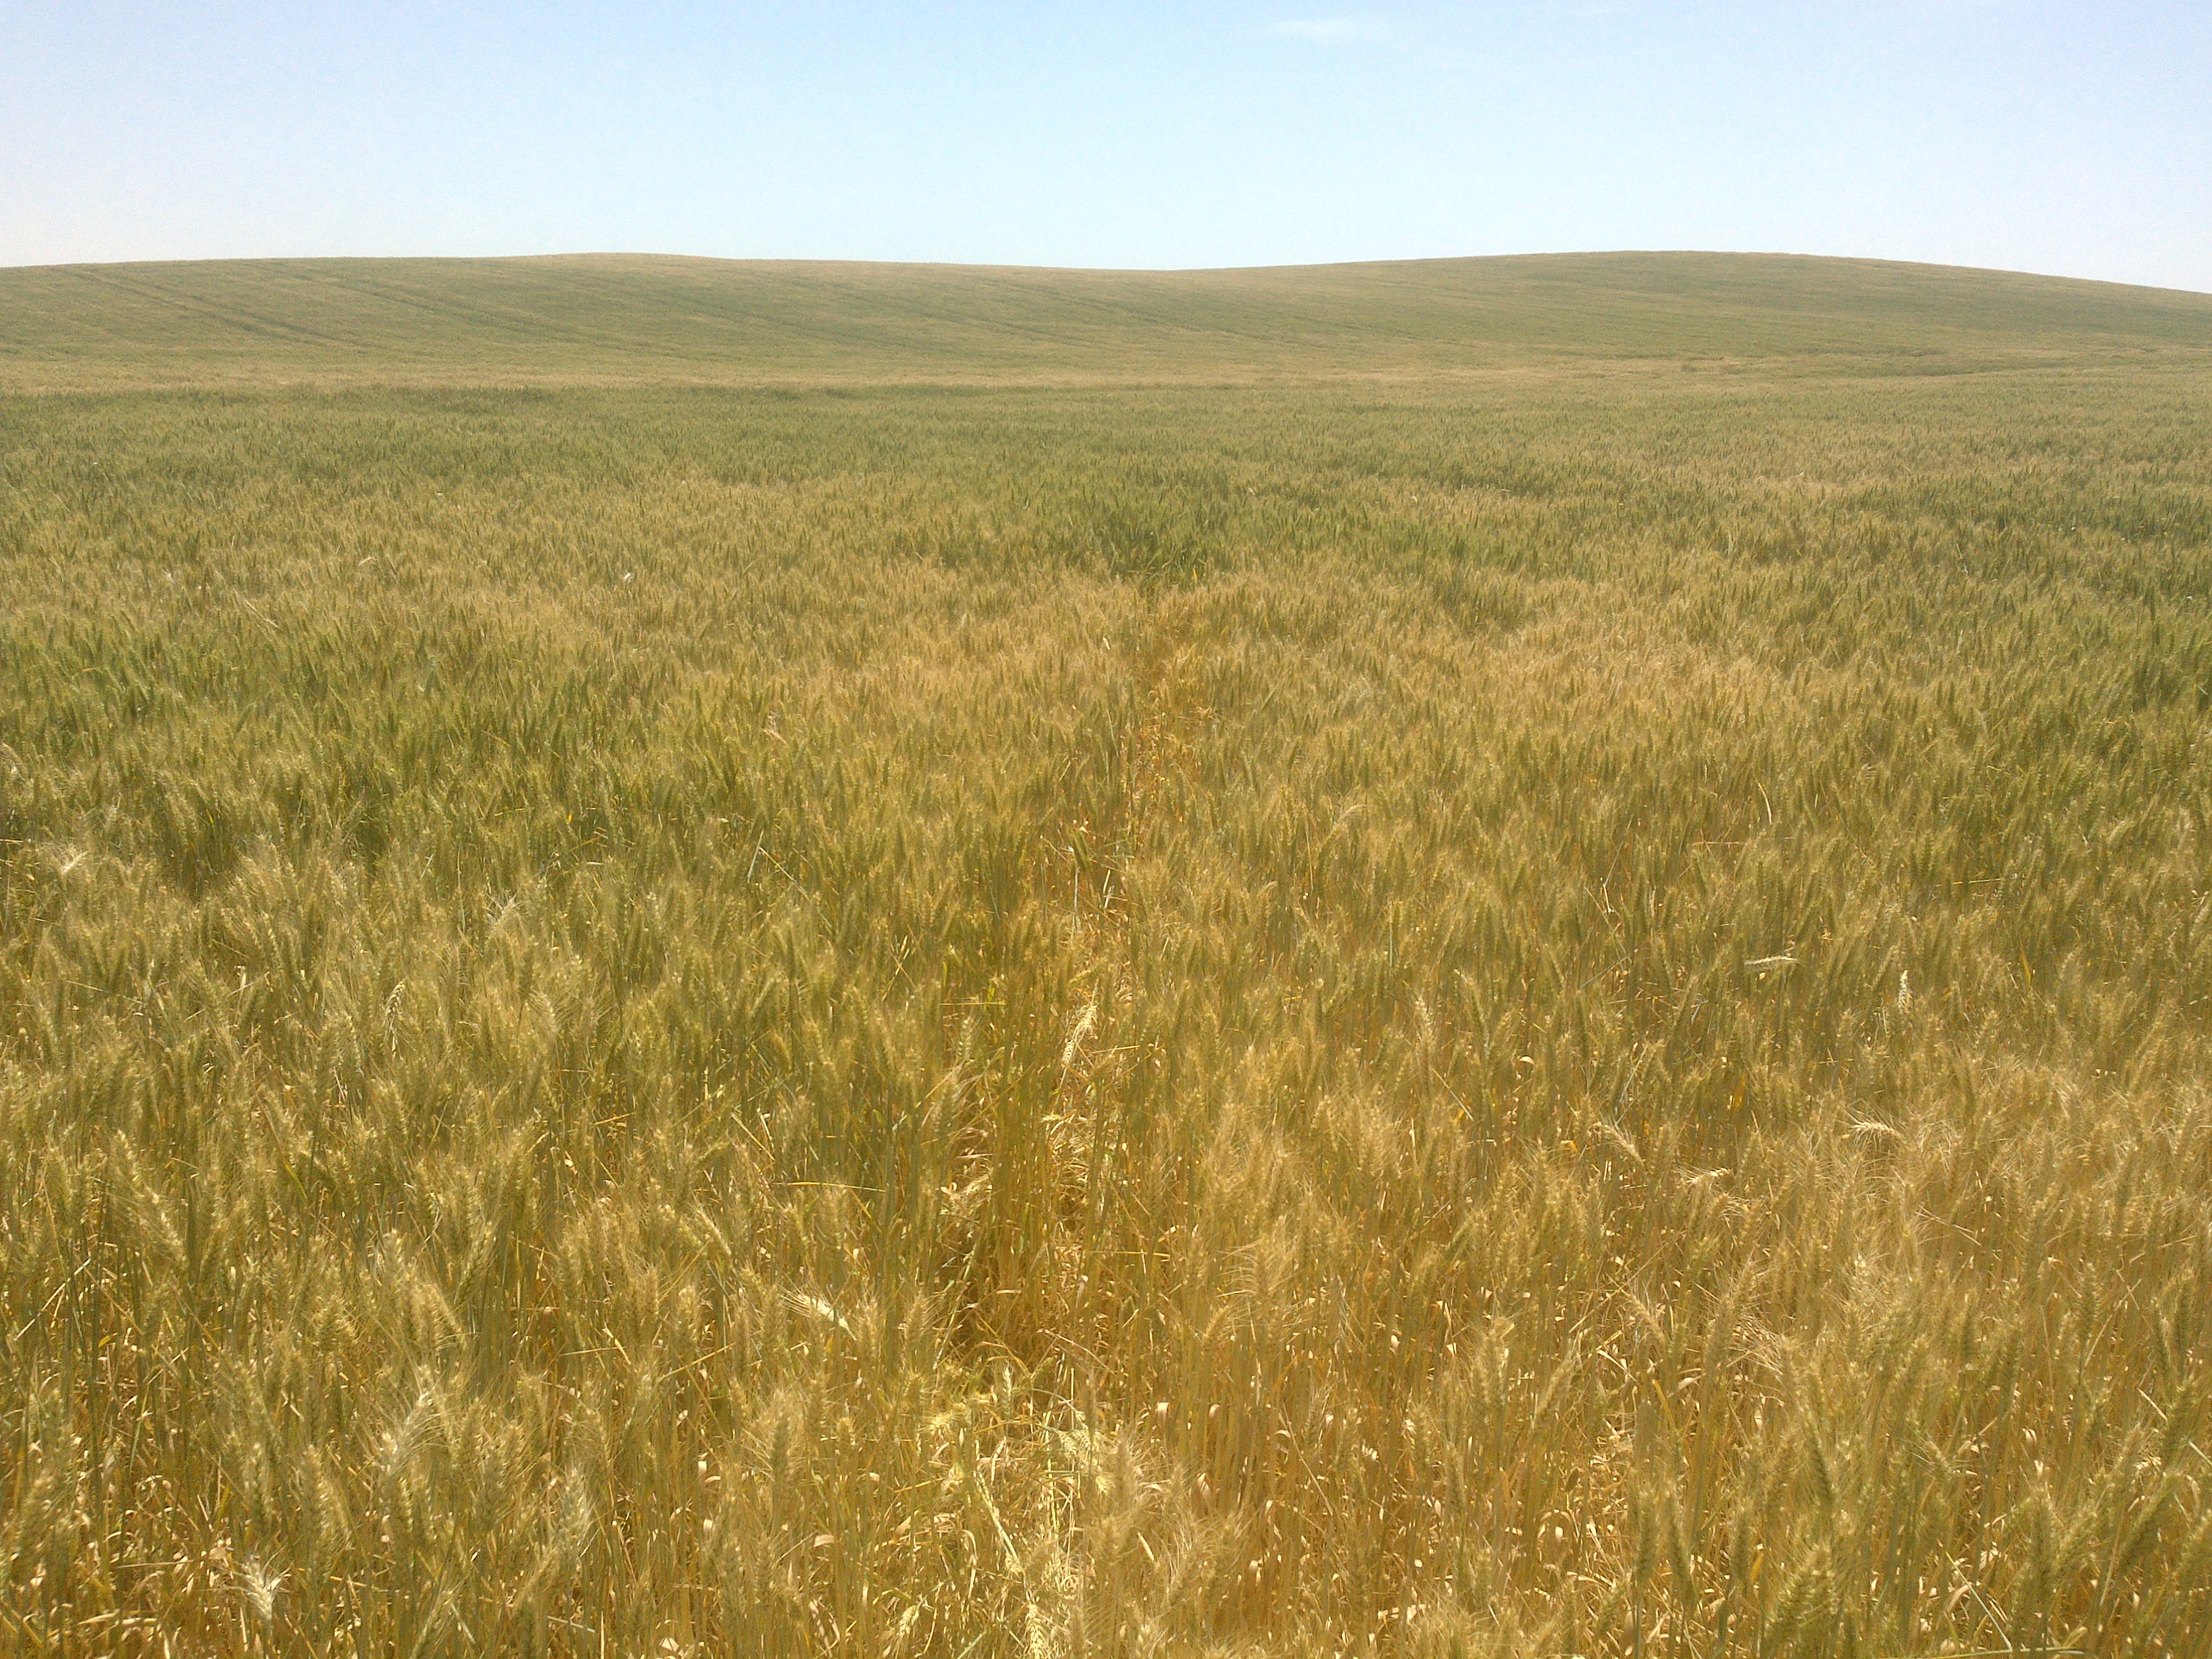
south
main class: Cropland
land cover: Durum wheat
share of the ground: > 75 %
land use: Agriculture (excluding fallow land and kitchen gardens)
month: May
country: ES
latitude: 37.8405
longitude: -4.6364
